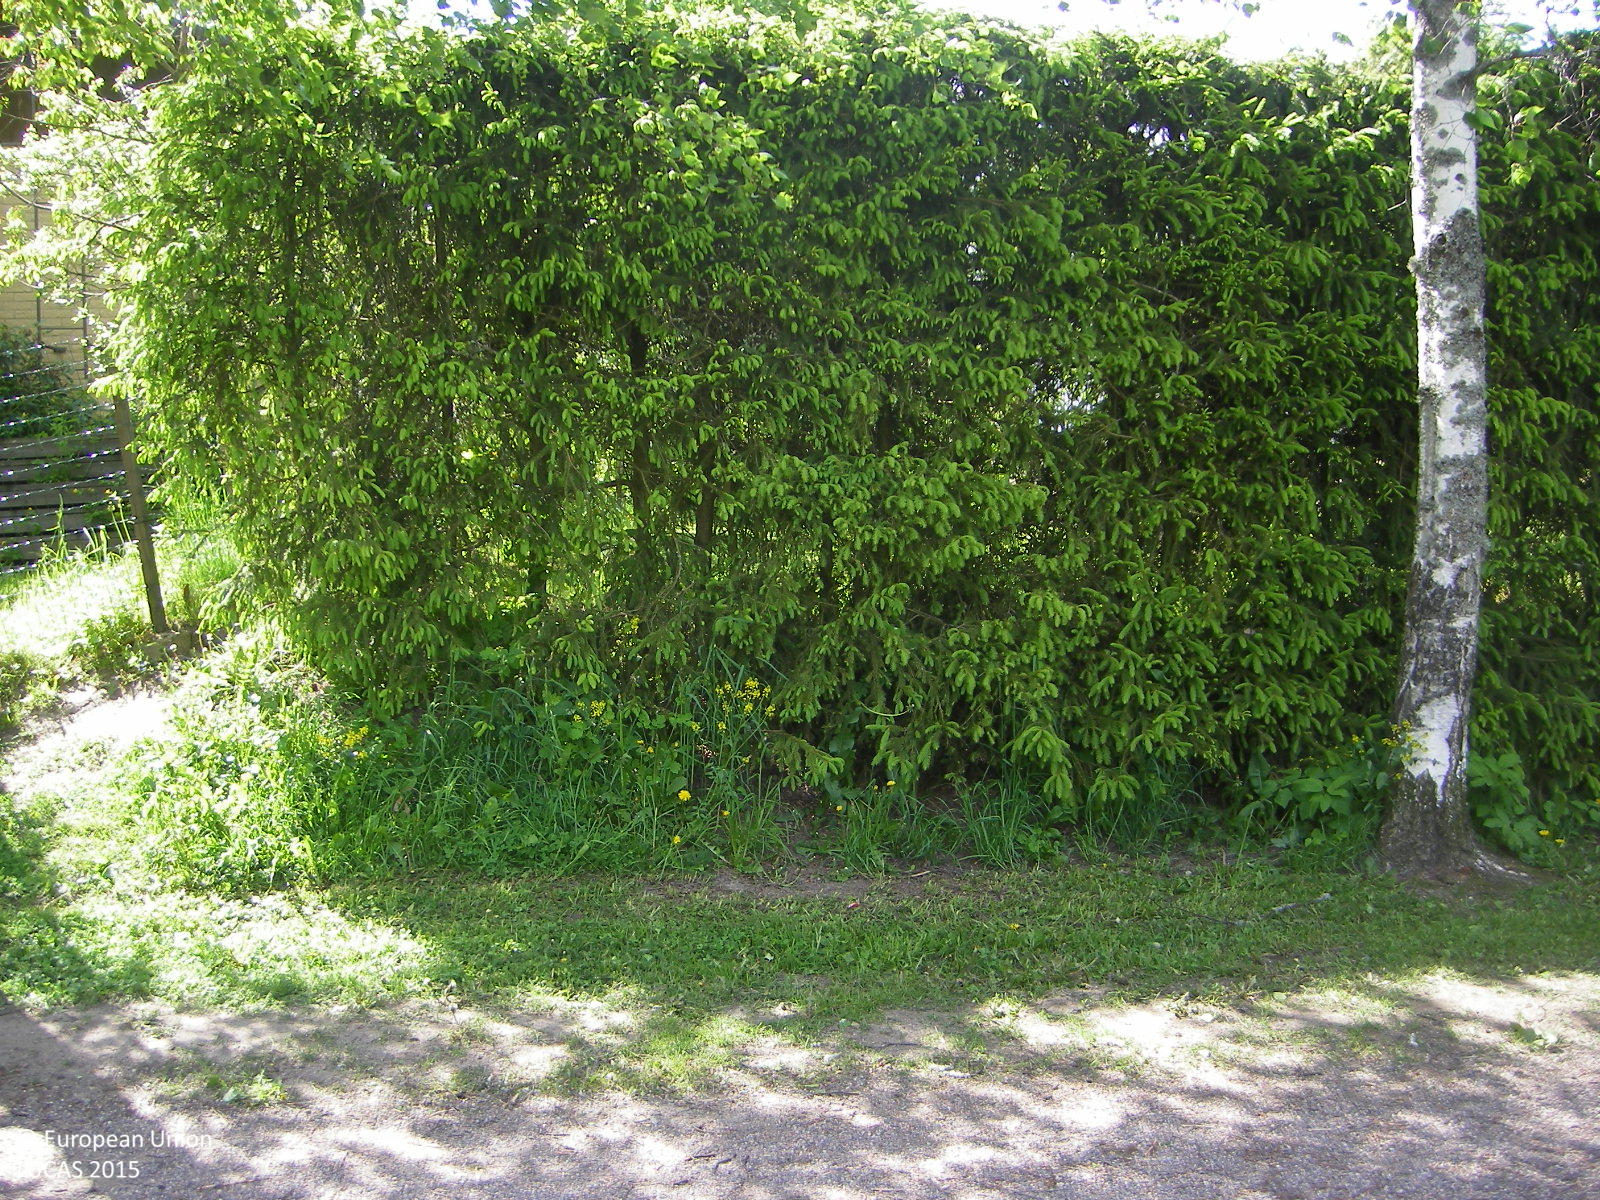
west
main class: Grassland
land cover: Grassland with sparse tree/shrub cover
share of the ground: > 75 %
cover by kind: herbaceous plants 90 %, broadleaved forest trees 5 %, shrubs 5 %
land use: Amenities, museums, leisure
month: June
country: FI
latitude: 60.2775
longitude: 24.7783
